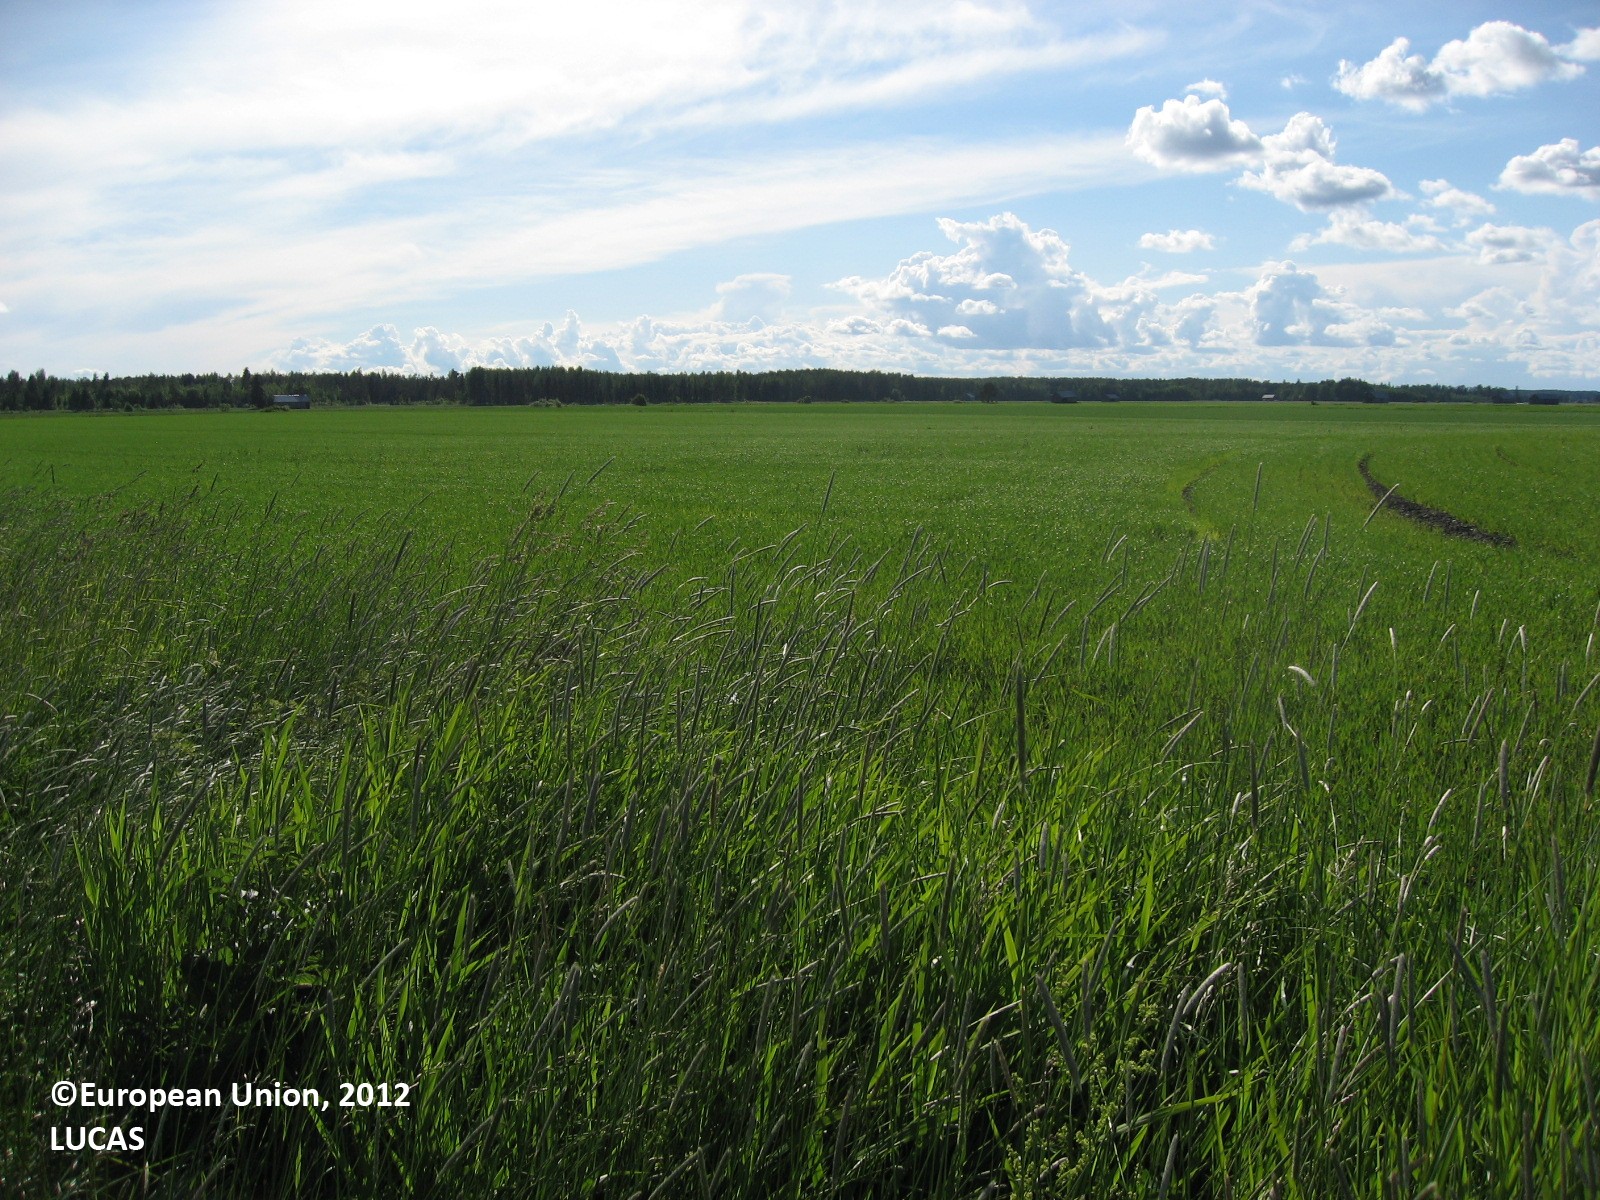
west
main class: Cropland
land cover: Common wheat
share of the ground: 50 - 75 %
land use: Agriculture (excluding fallow land and kitchen gardens)
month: June
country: FI
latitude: 60.5871
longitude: 26.3051
